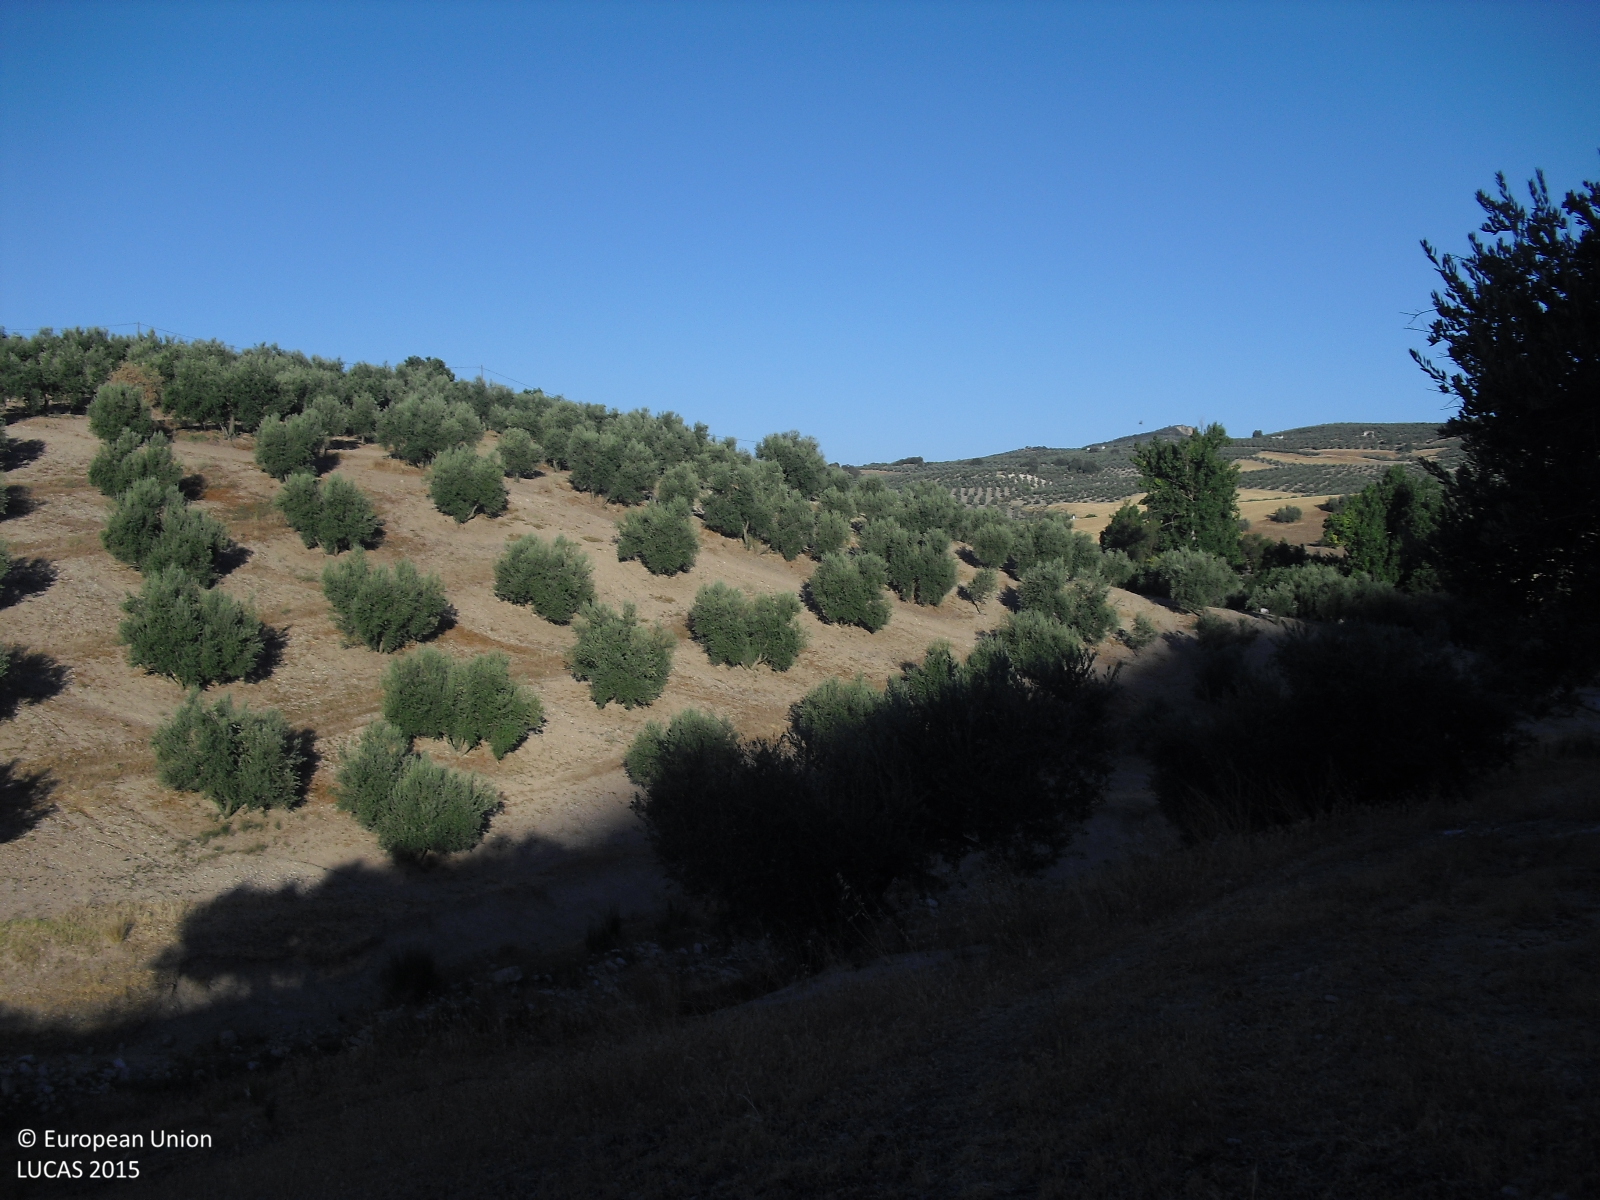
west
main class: Cropland
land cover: Olive groves
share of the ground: 10 - 25 %
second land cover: Spontaneously vegetated surfaces
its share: 25 - 50 %
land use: Agriculture (excluding fallow land and kitchen gardens)
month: August
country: ES
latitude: 37.2607
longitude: -4.1015
